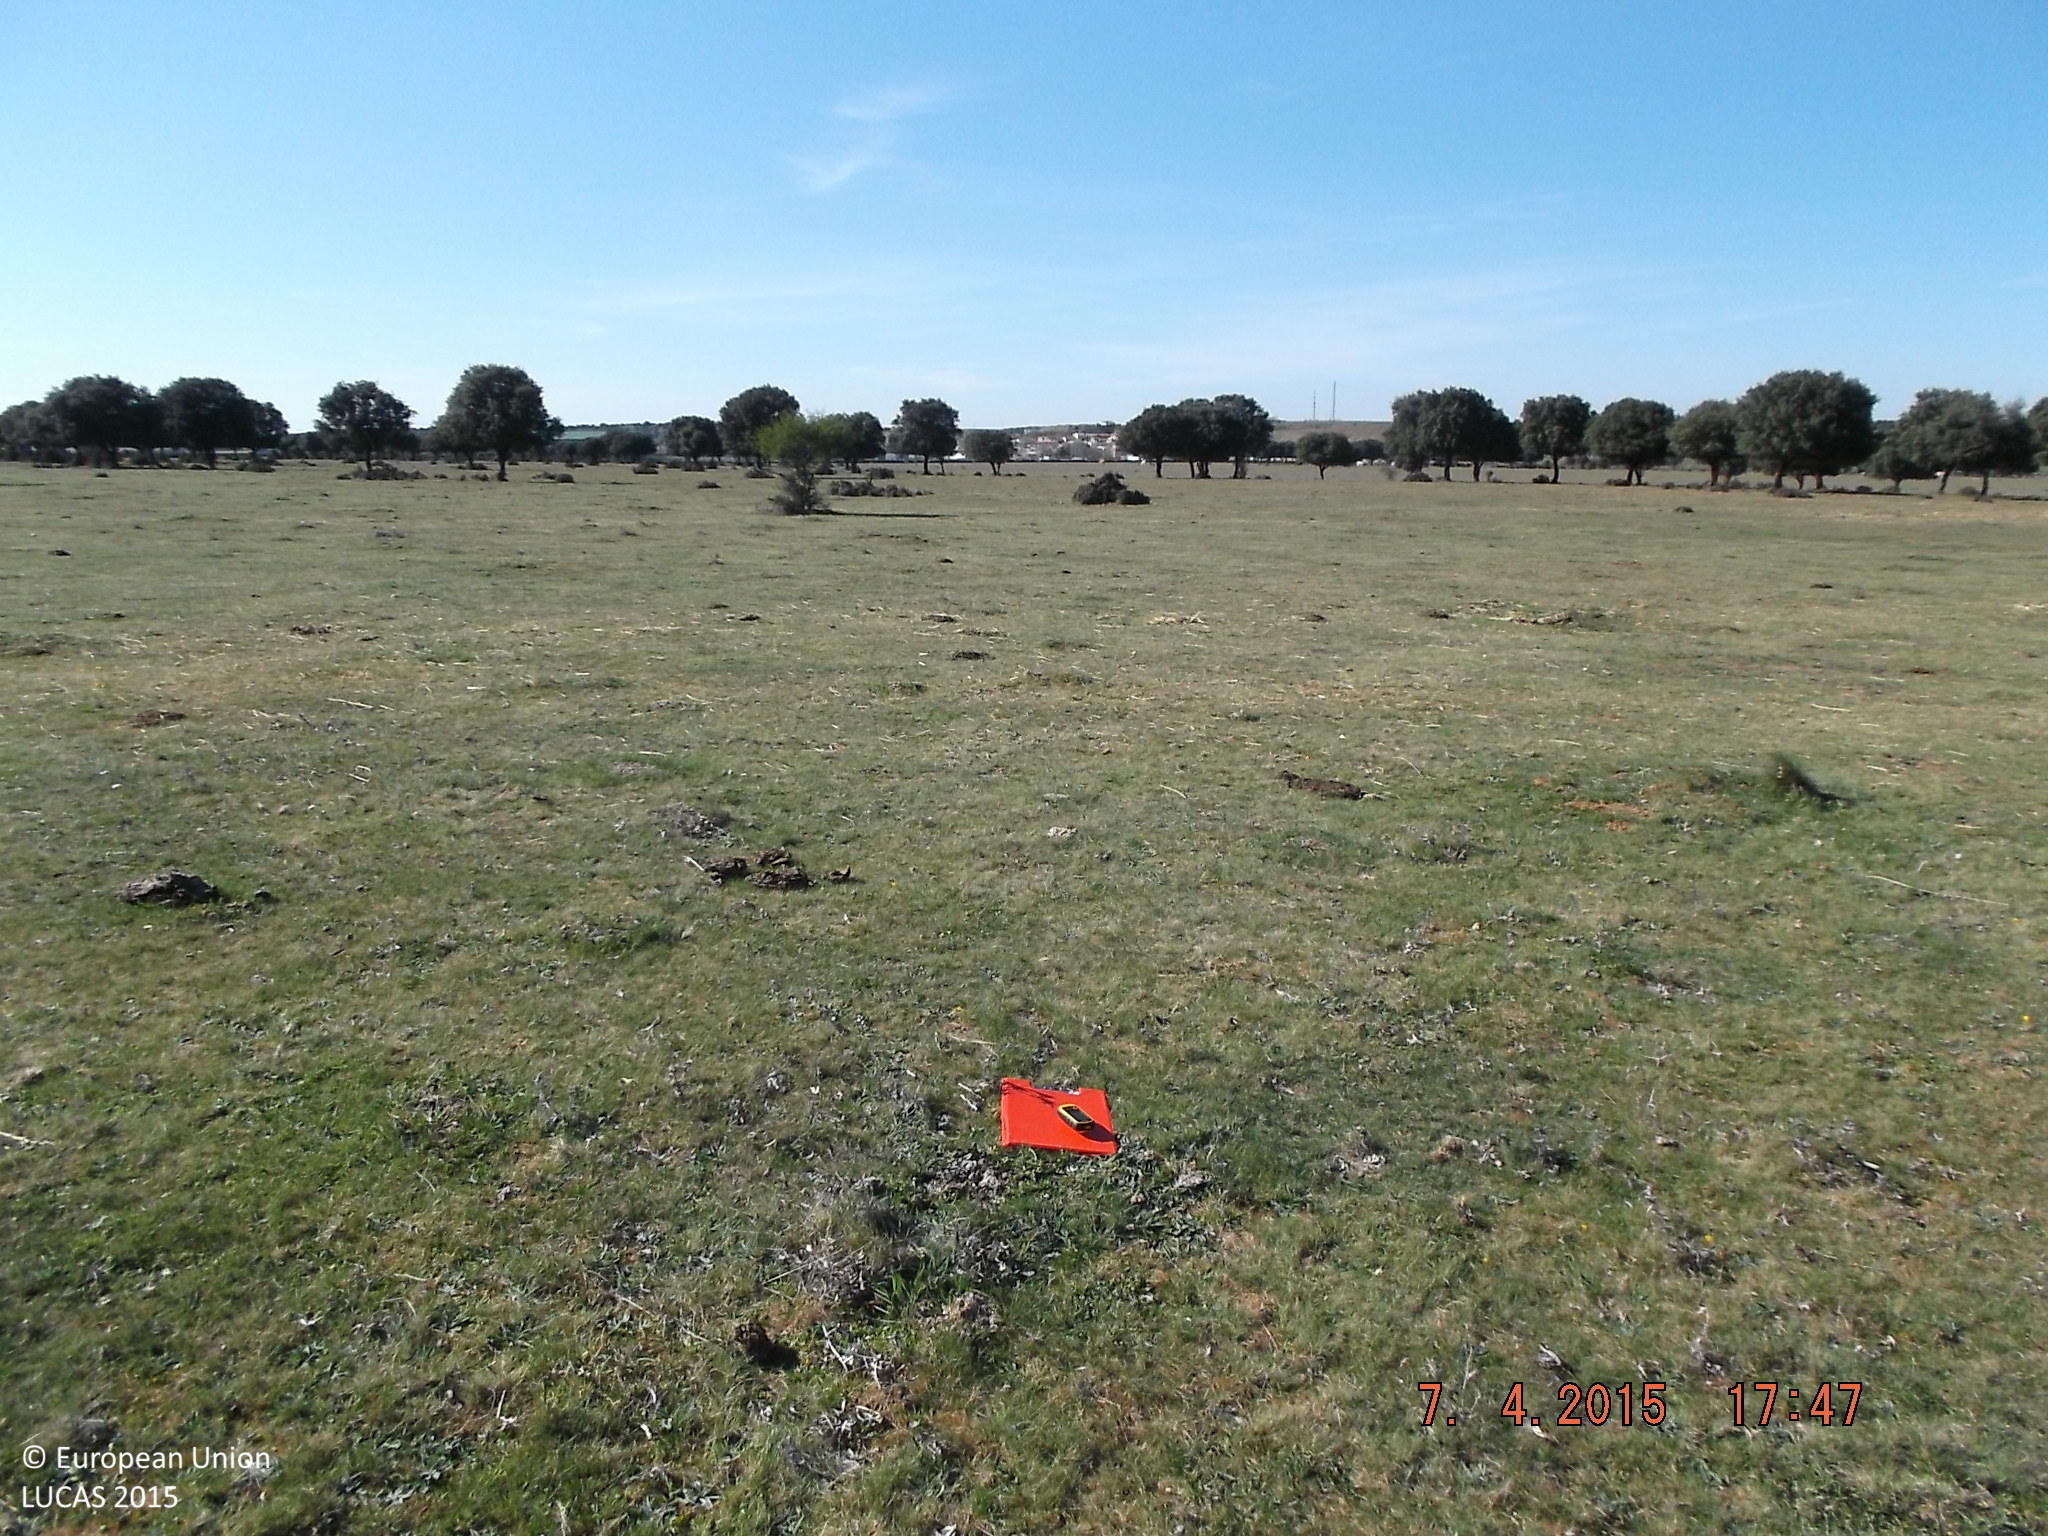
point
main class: Grassland
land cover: Grassland without tree/shrub cover
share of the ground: > 75 %
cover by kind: herbaceous plants 100 %
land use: Agriculture (excluding fallow land and kitchen gardens)
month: April
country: ES
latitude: 40.8139
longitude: -5.9308
